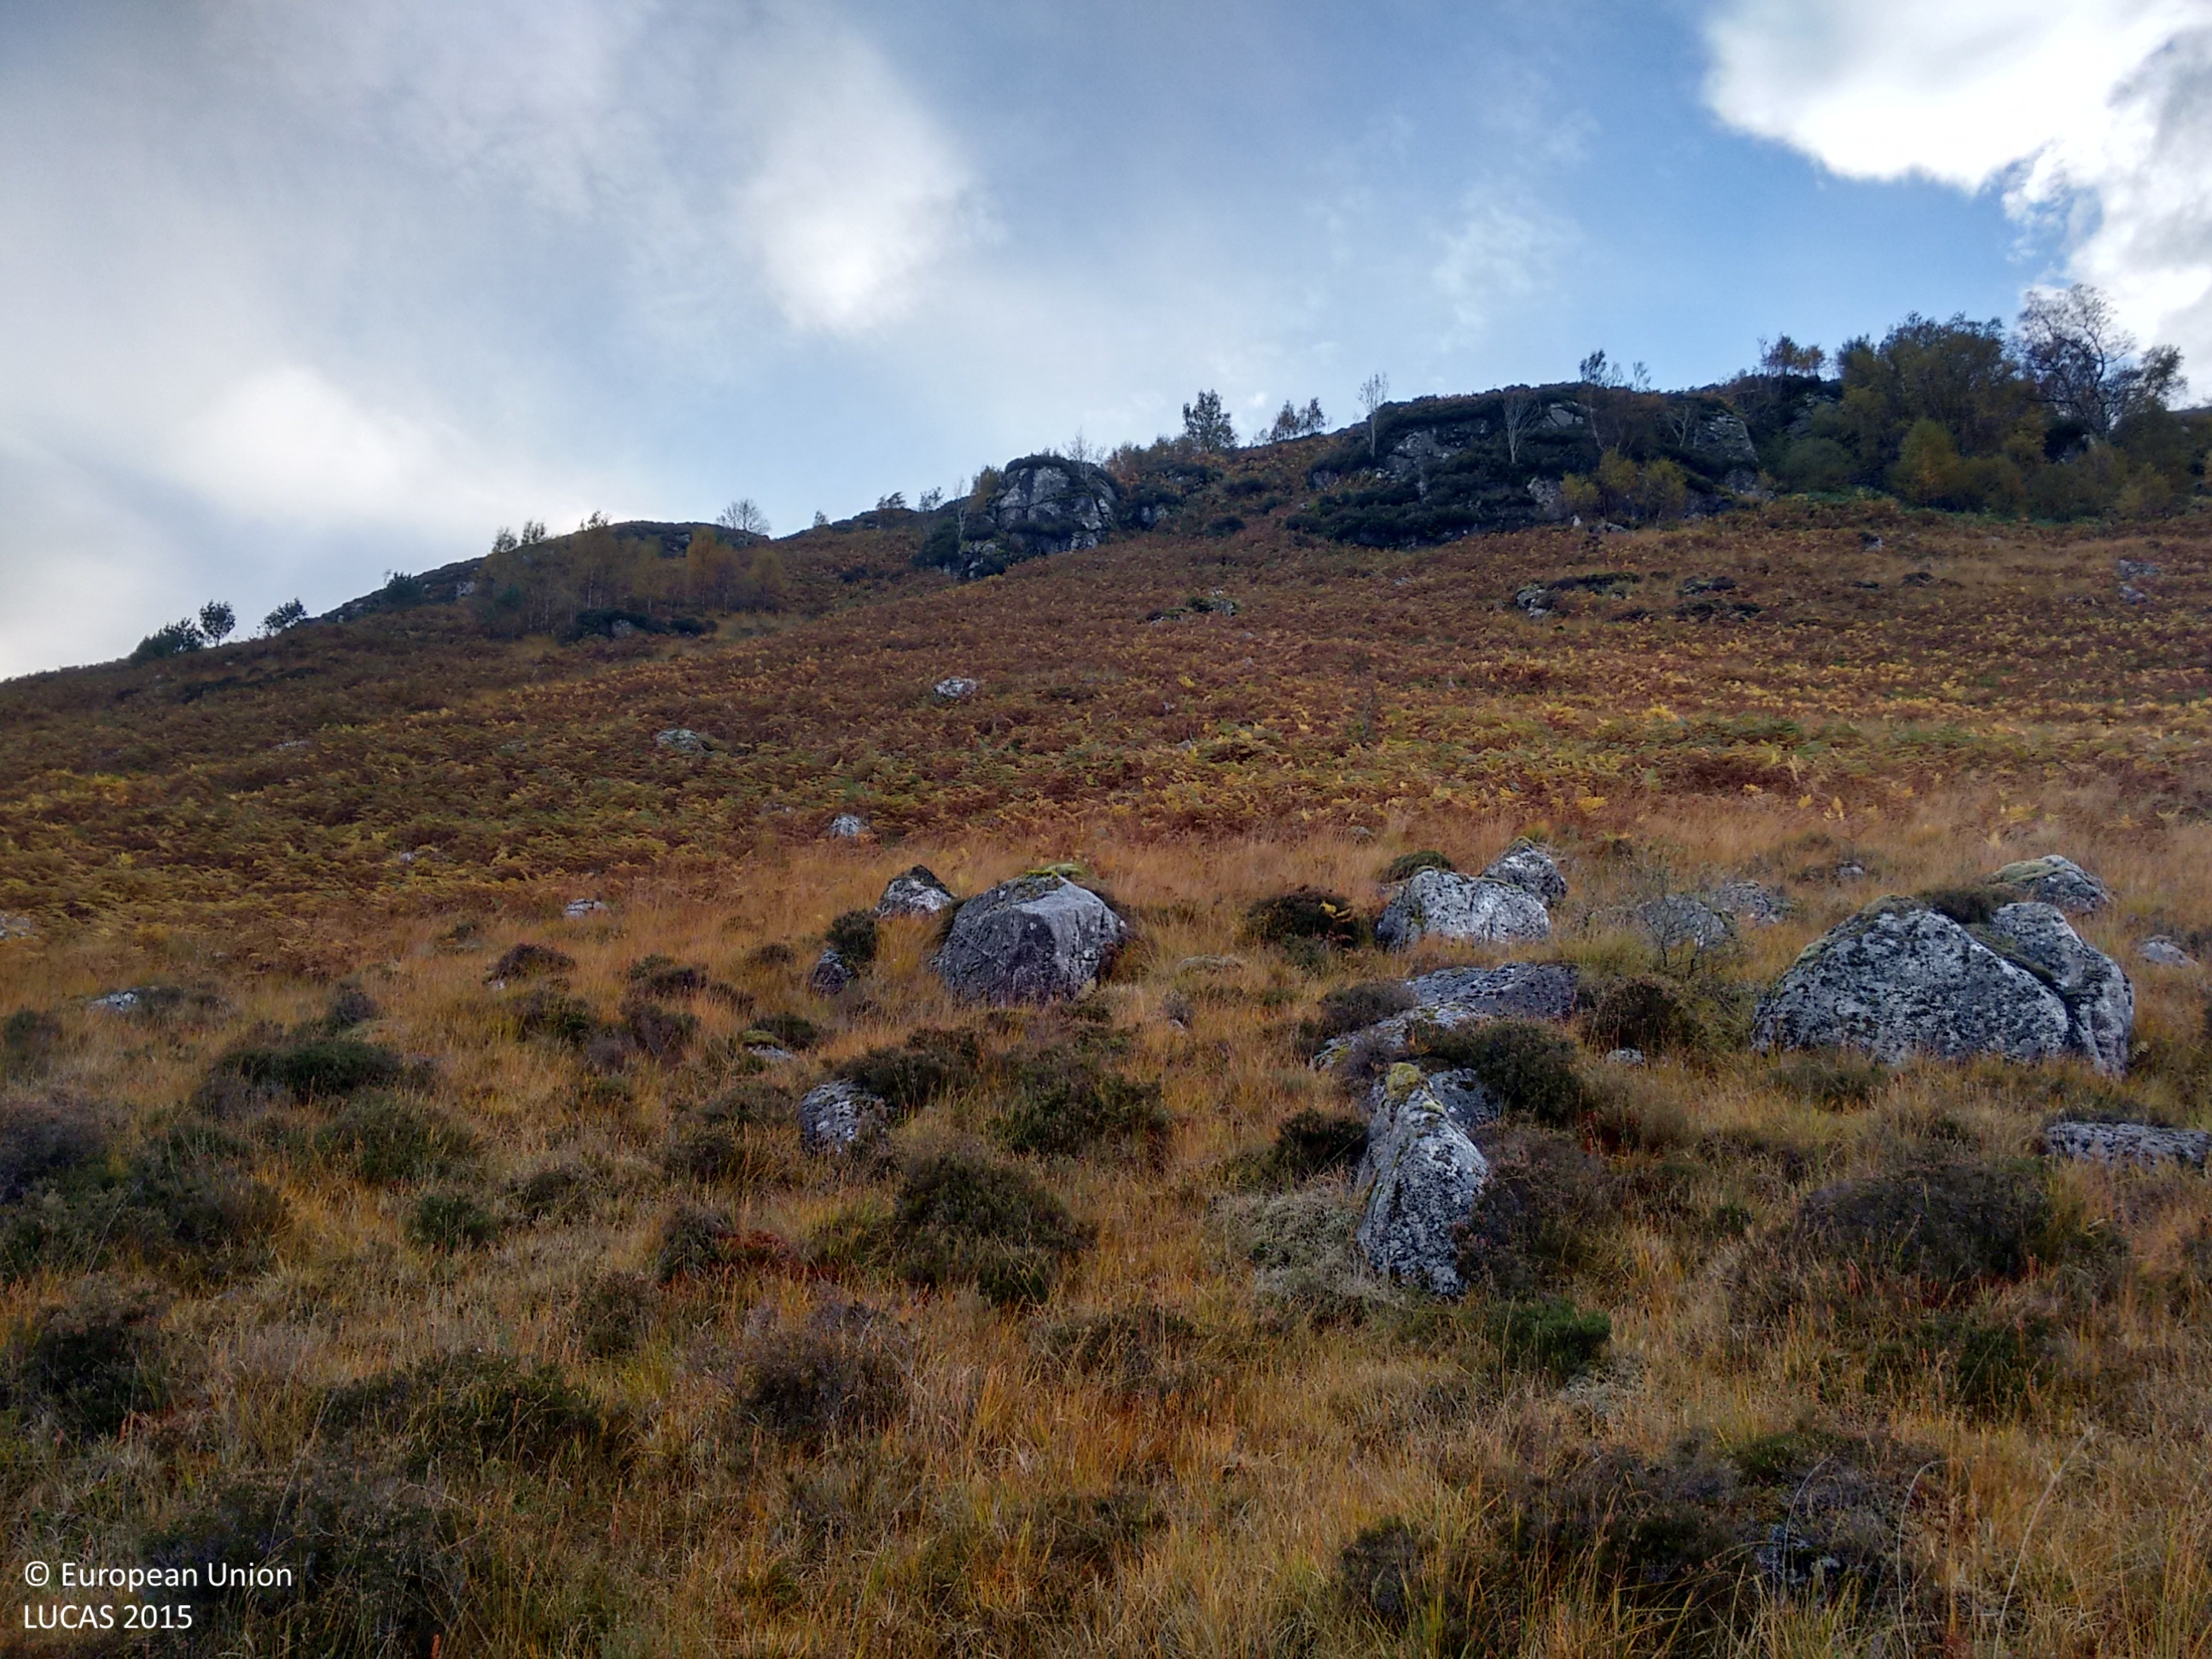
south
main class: Shrubland
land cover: Shrubland without tree cover
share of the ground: > 75 %
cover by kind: shrubs 60 %, herbaceous plants 30 %, lichens and mosses 5 %
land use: Agriculture (excluding fallow land and kitchen gardens)
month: October
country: GB
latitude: 56.6857
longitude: -5.5144
